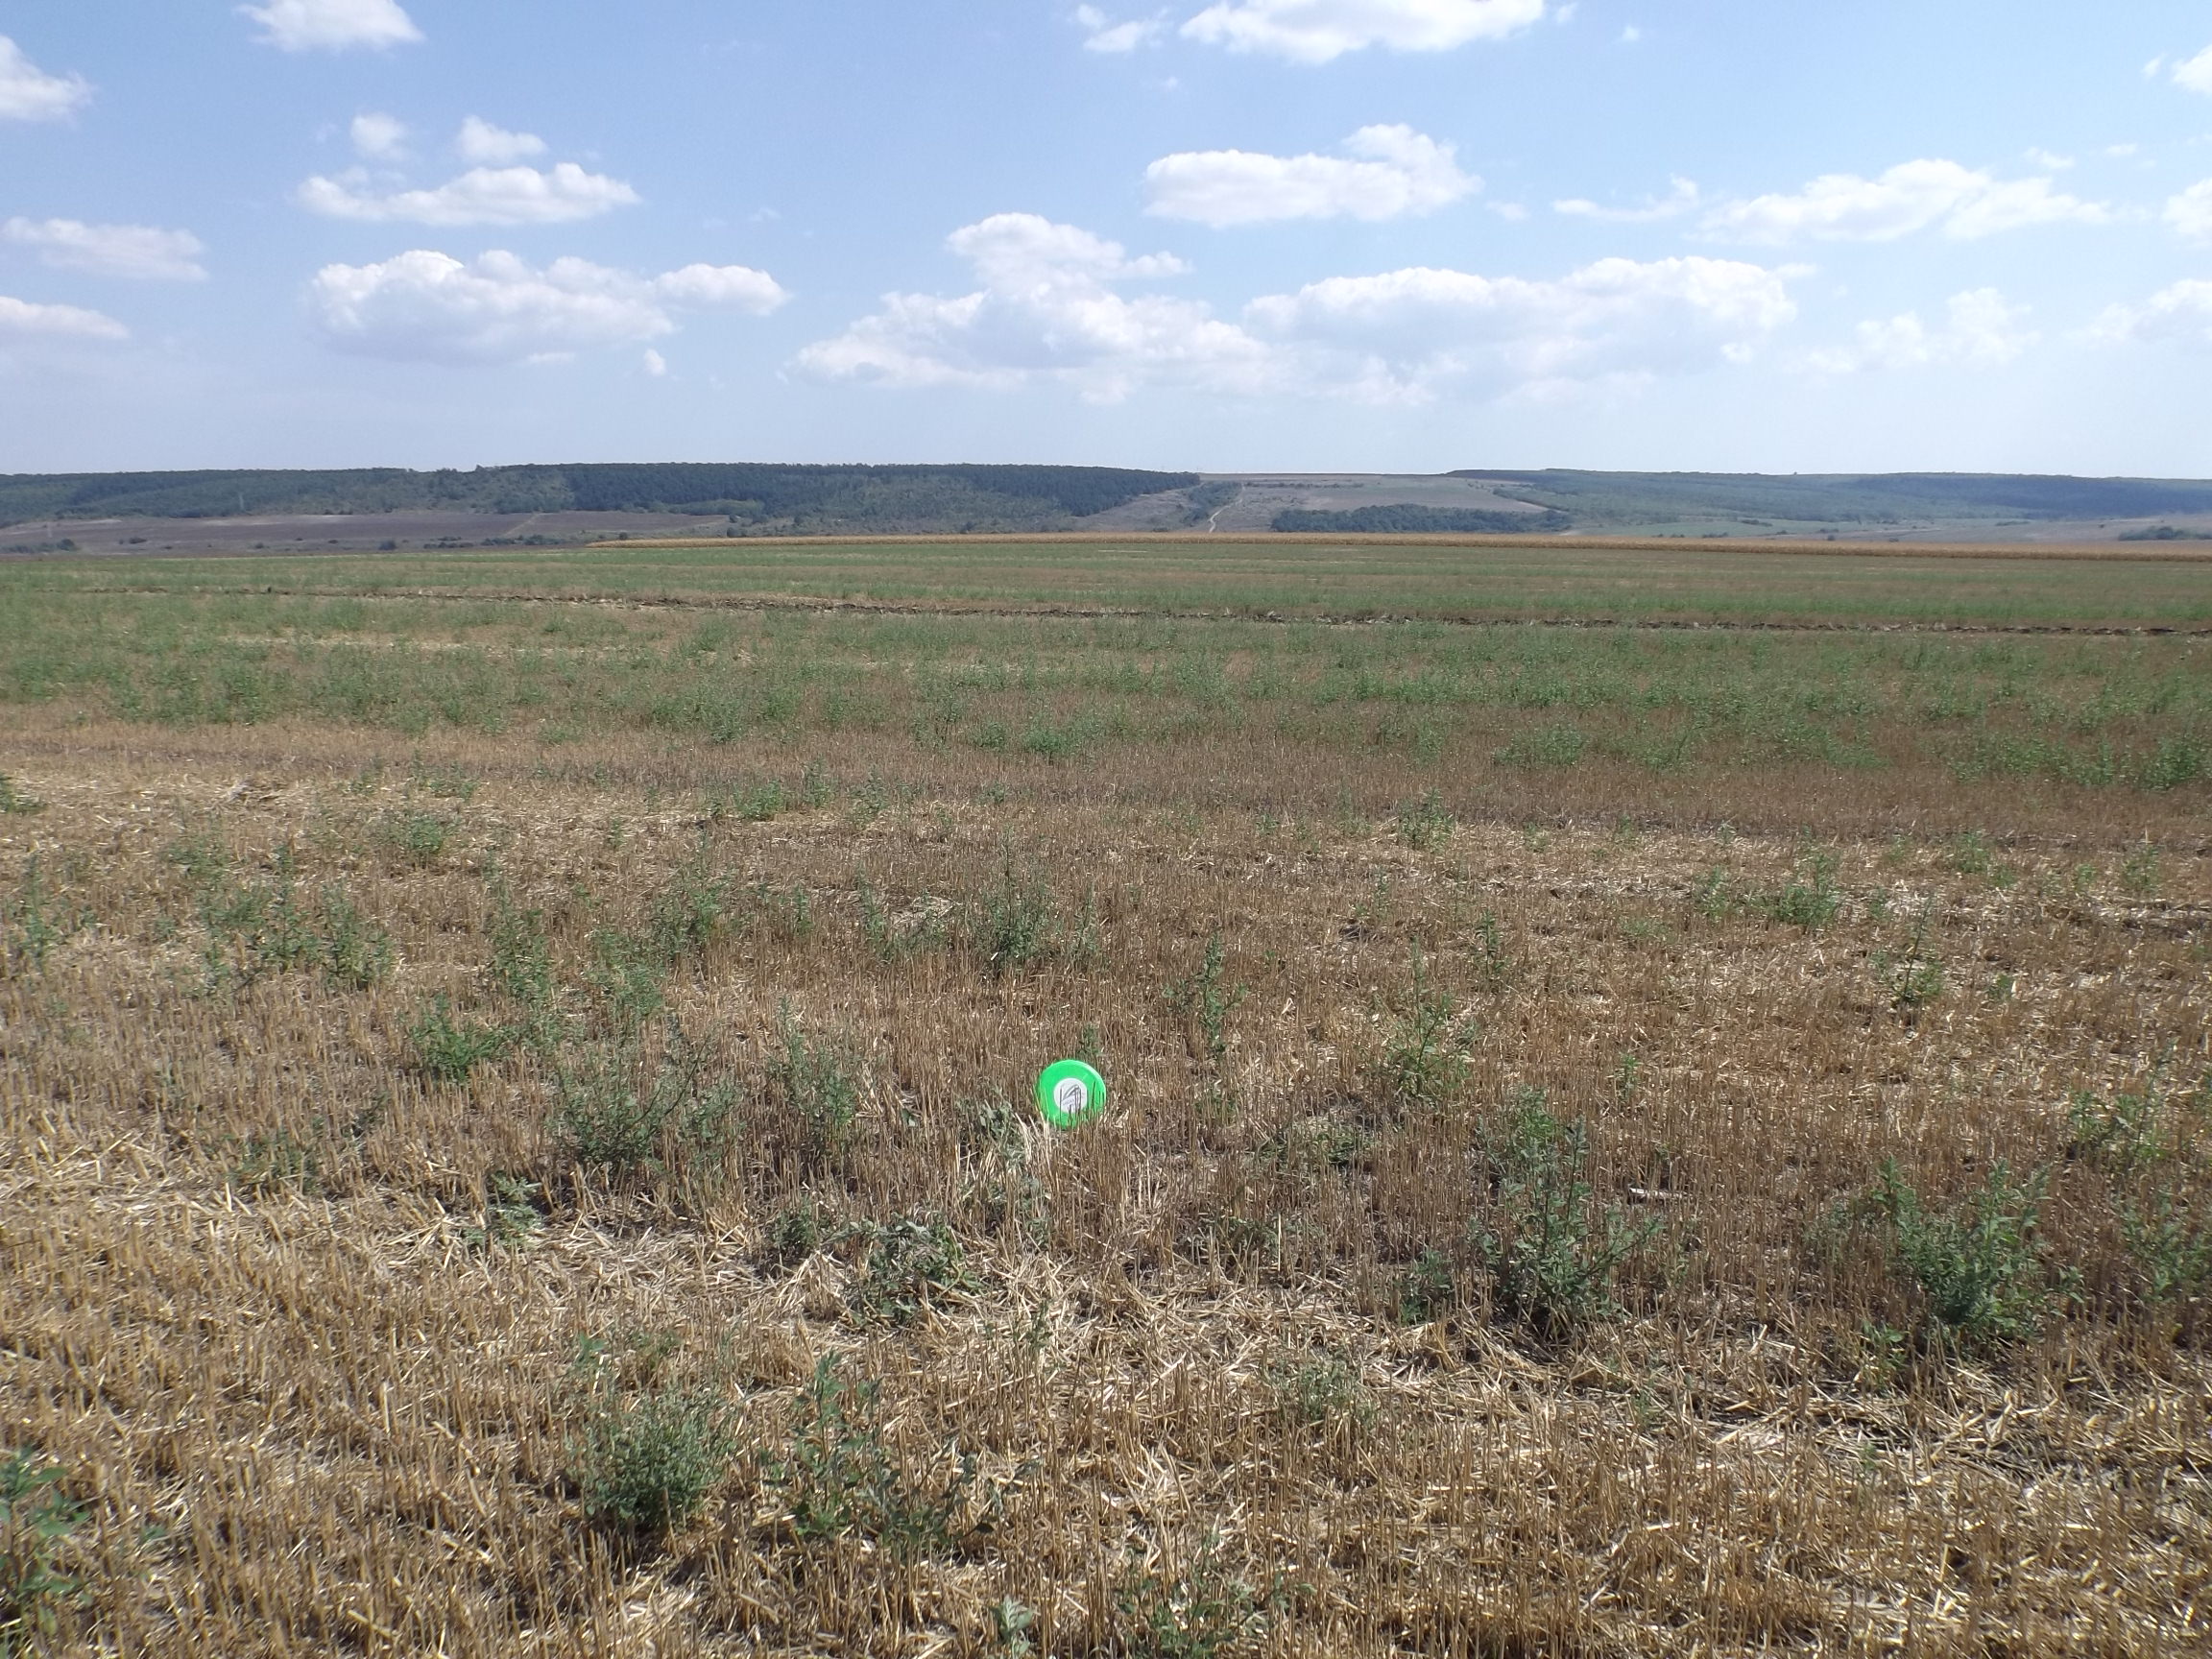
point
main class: Cropland
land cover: Common wheat
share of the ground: 50 - 75 %
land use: Agriculture (excluding fallow land and kitchen gardens)
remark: Harvested field
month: August
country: BG
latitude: 43.4406
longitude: 27.4893
